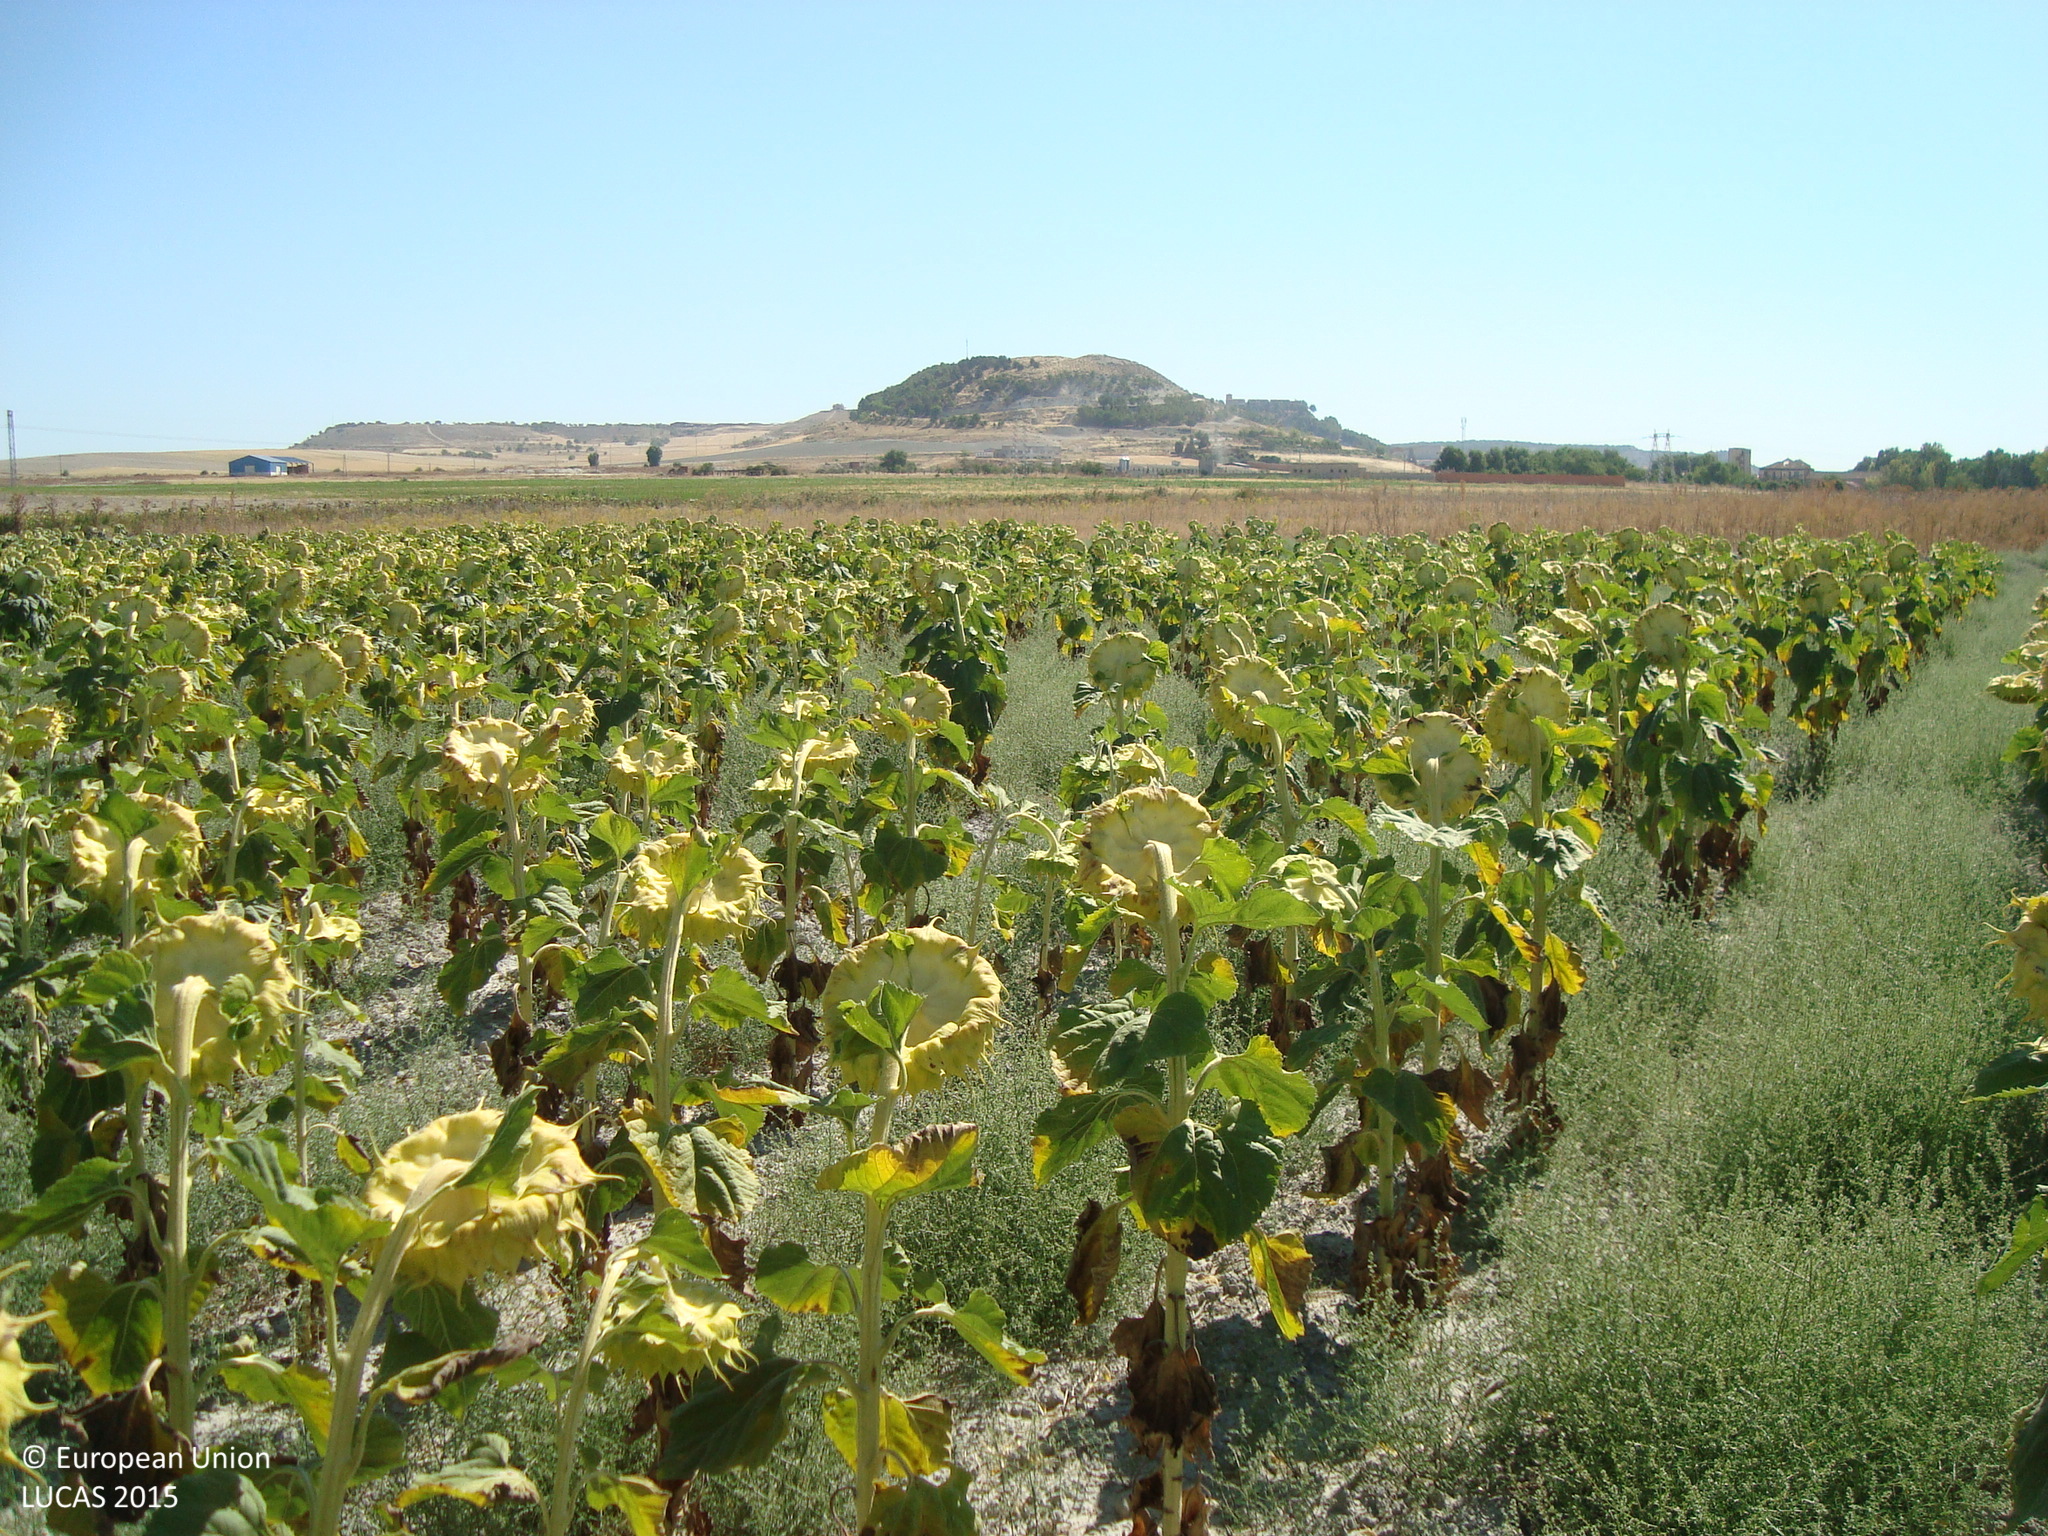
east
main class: Cropland
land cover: Sunflower
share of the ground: > 75 %
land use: Agriculture (excluding fallow land and kitchen gardens)
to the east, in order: Sunflower; Other bare soil; Grassland without tree/shrub cover; Rivers and streams; Barley
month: August
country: ES
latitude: 41.4774
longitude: -4.6150
